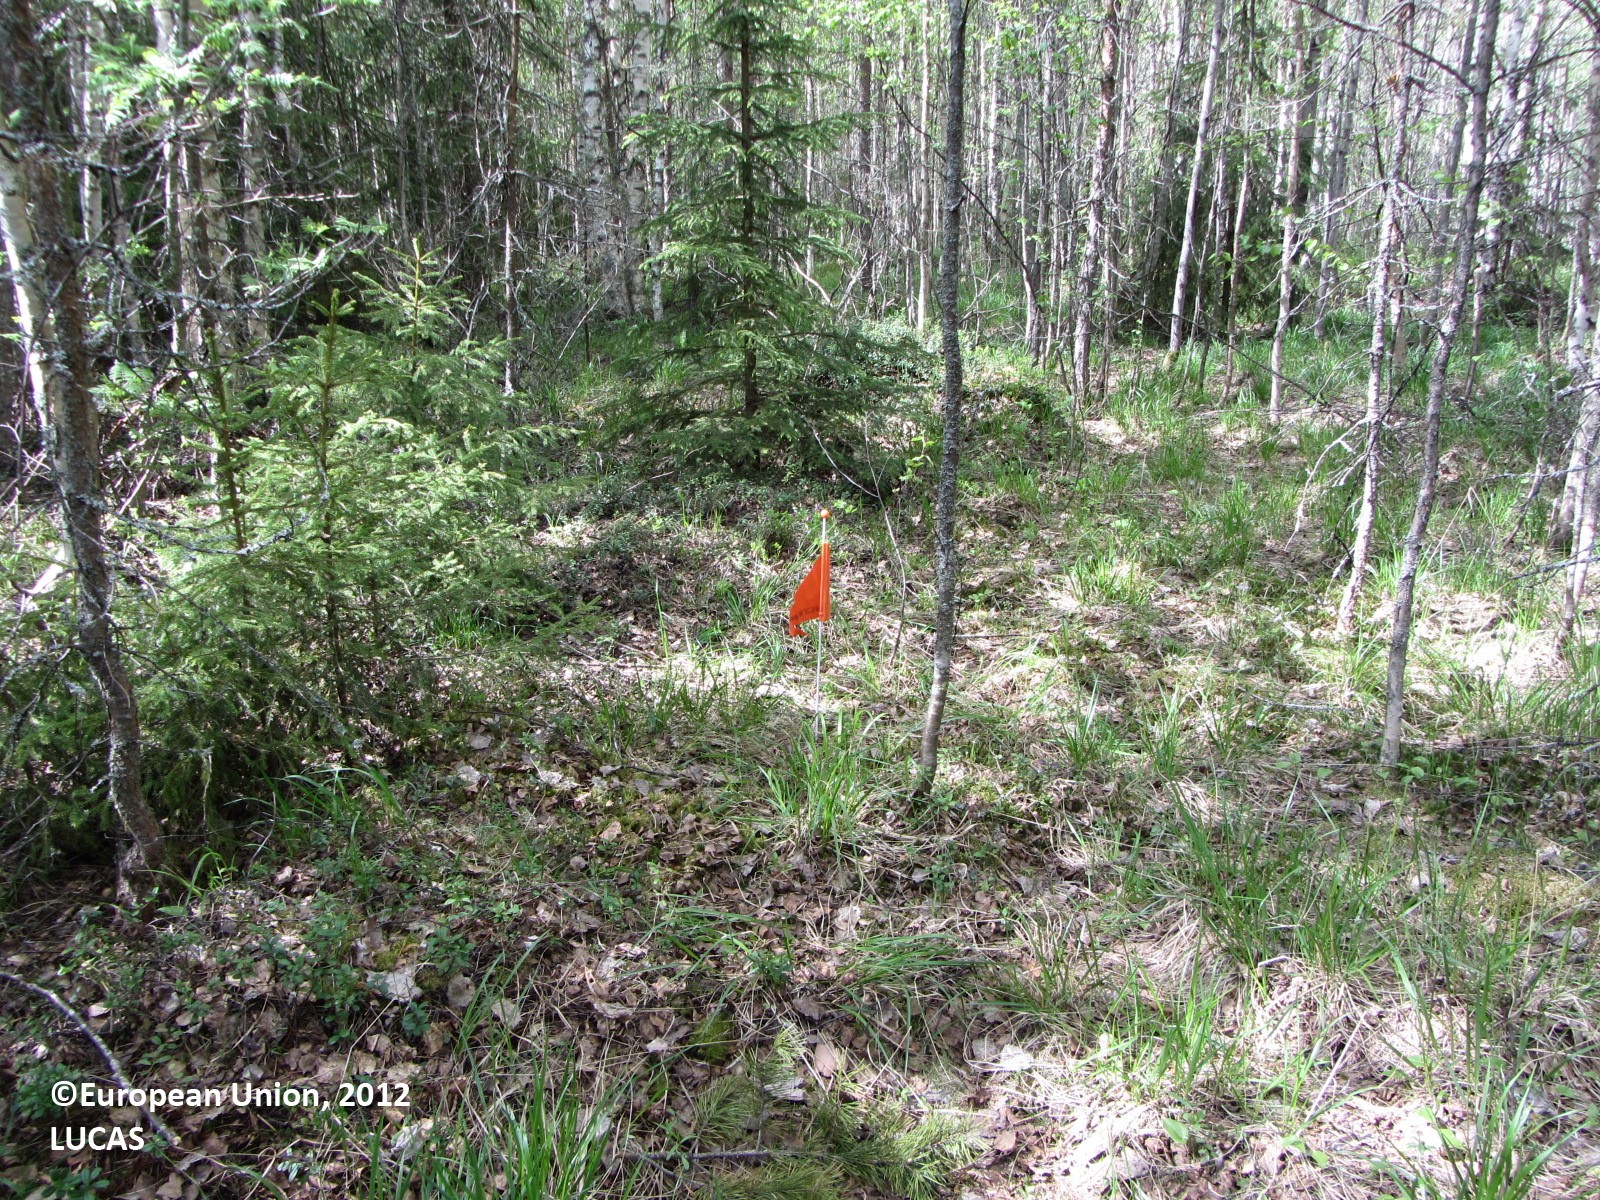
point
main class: Woodland
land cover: Spruce dominated mixed woodland
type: boreal forest
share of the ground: > 75 %
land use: Forestry
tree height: > 5 m
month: May
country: FI
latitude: 62.5279
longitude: 25.4409
